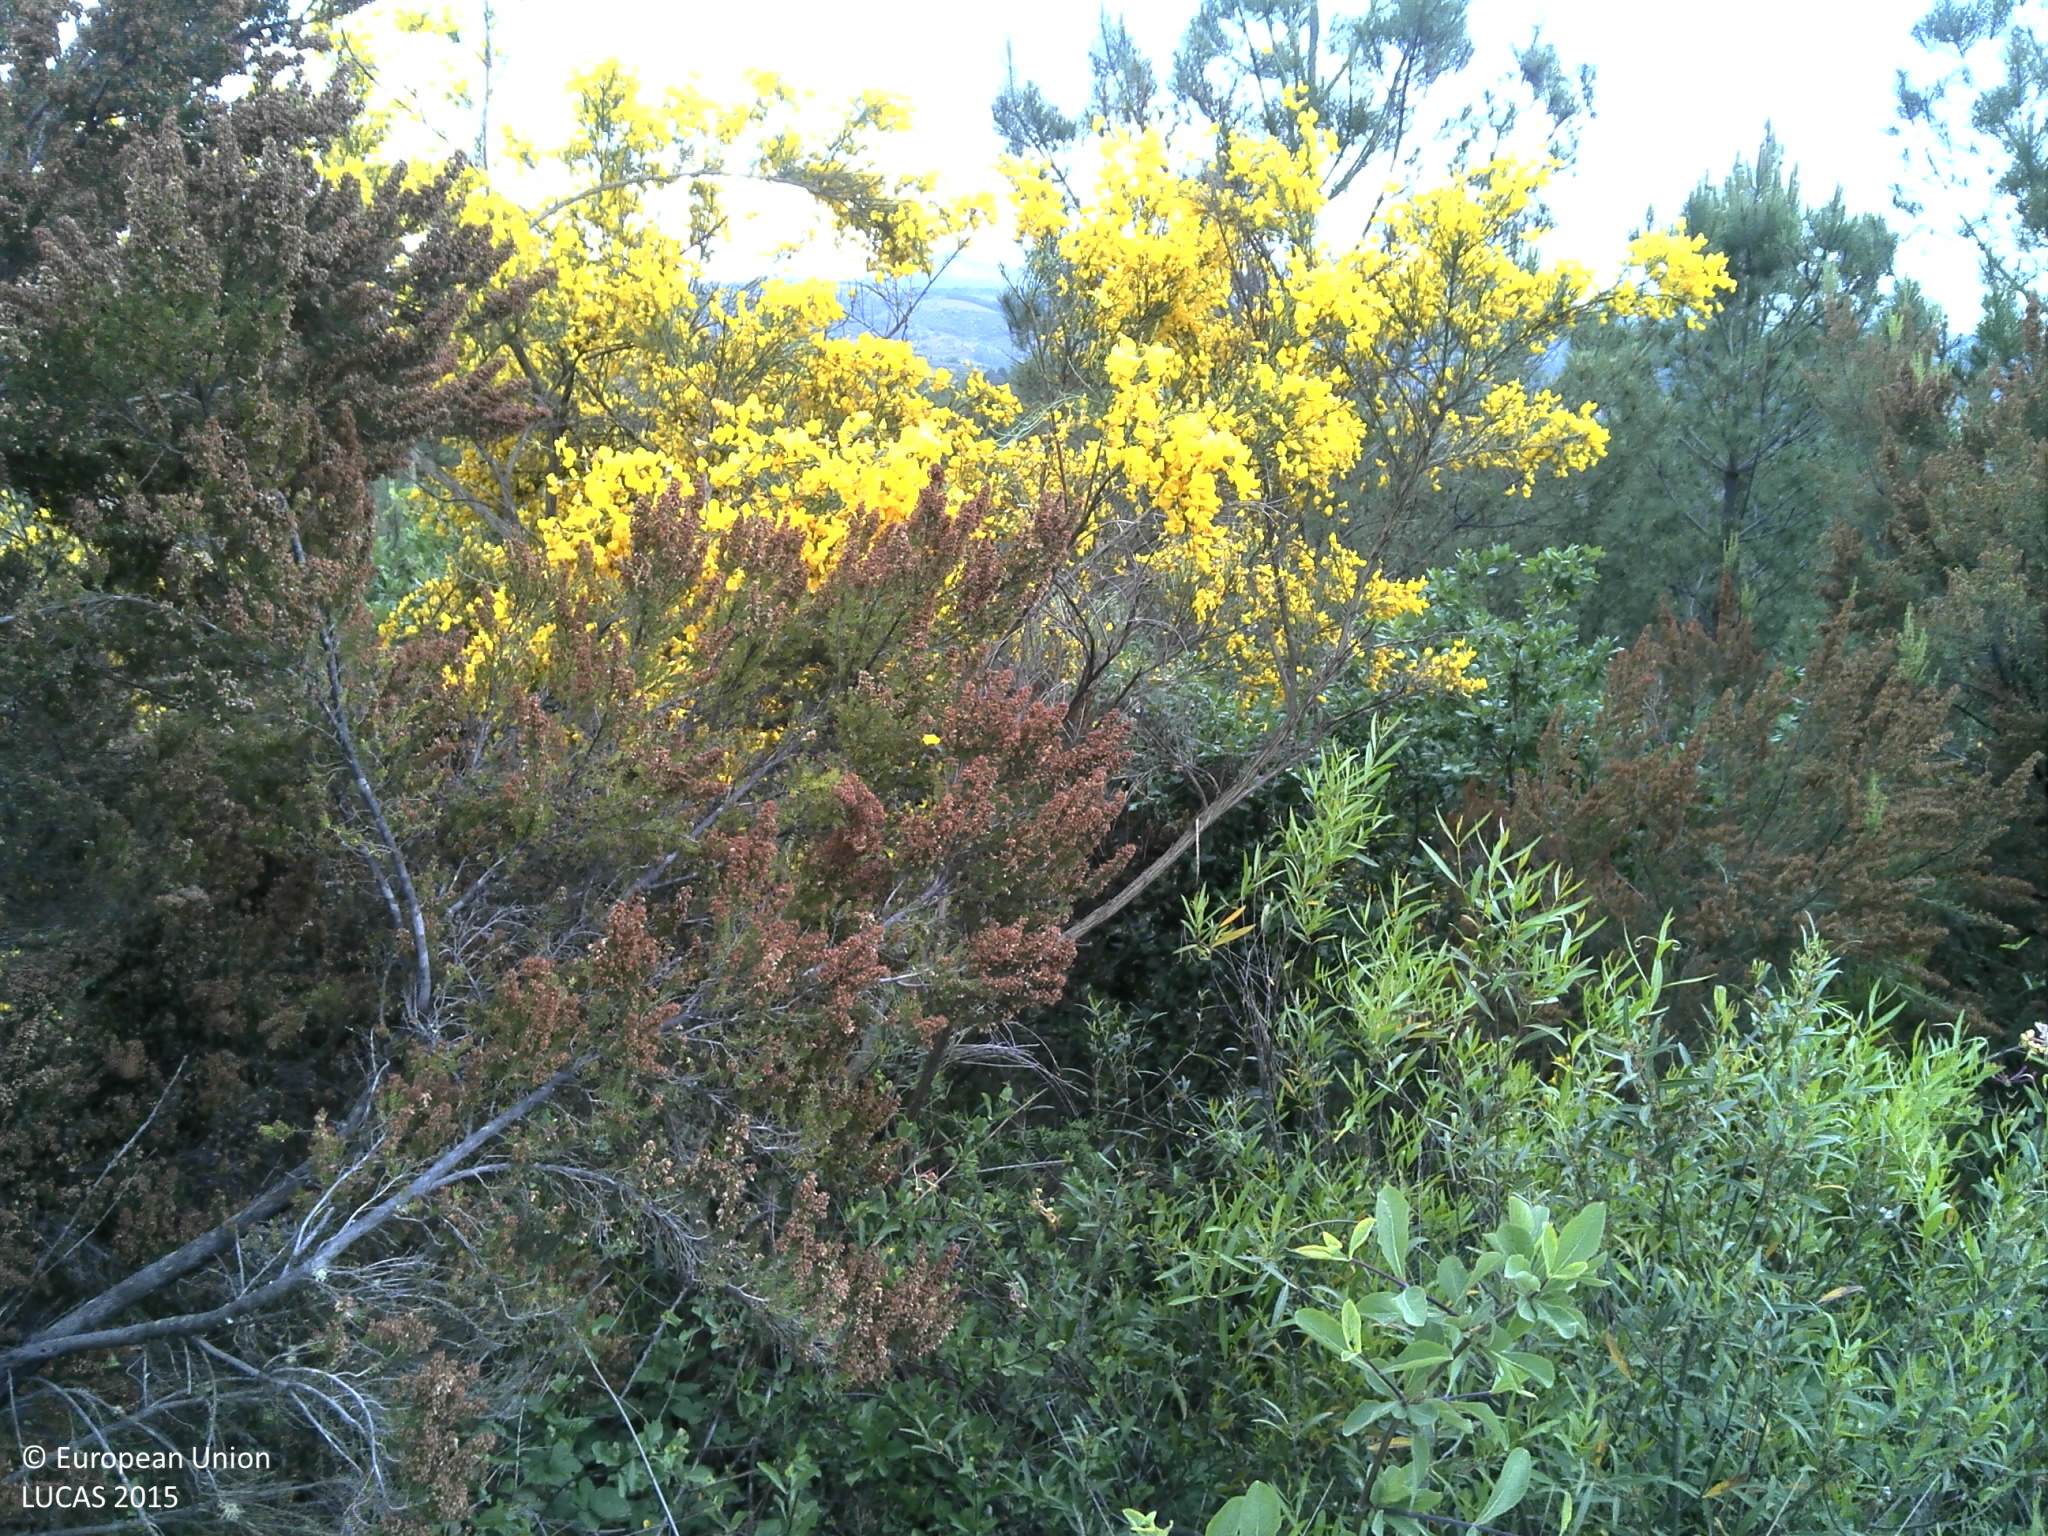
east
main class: Shrubland
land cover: Shrubland with sparse tree cover
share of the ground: > 75 %
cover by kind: shrubs 80 %, herbaceous plants 10 %, broadleaved forest trees 5 %, unconsolidated bare surface 5 %
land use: Abandoned areas
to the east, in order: Shrubland with sparse tree cover; Pine dominated coniferous woodland; Shrubland with sparse tree cover; Grass margins; Paved roads, cycling and walking lanes; Grass margins; Olive groves; Shrubland with sparse tree cover; Shrubland without tree cover; Tracks; Shrubland without tree cover; Shrubland with sparse tree cover; Olive groves; Other fruit trees and berries; Olive groves
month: May
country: PT
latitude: 41.6448
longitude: -7.0098
